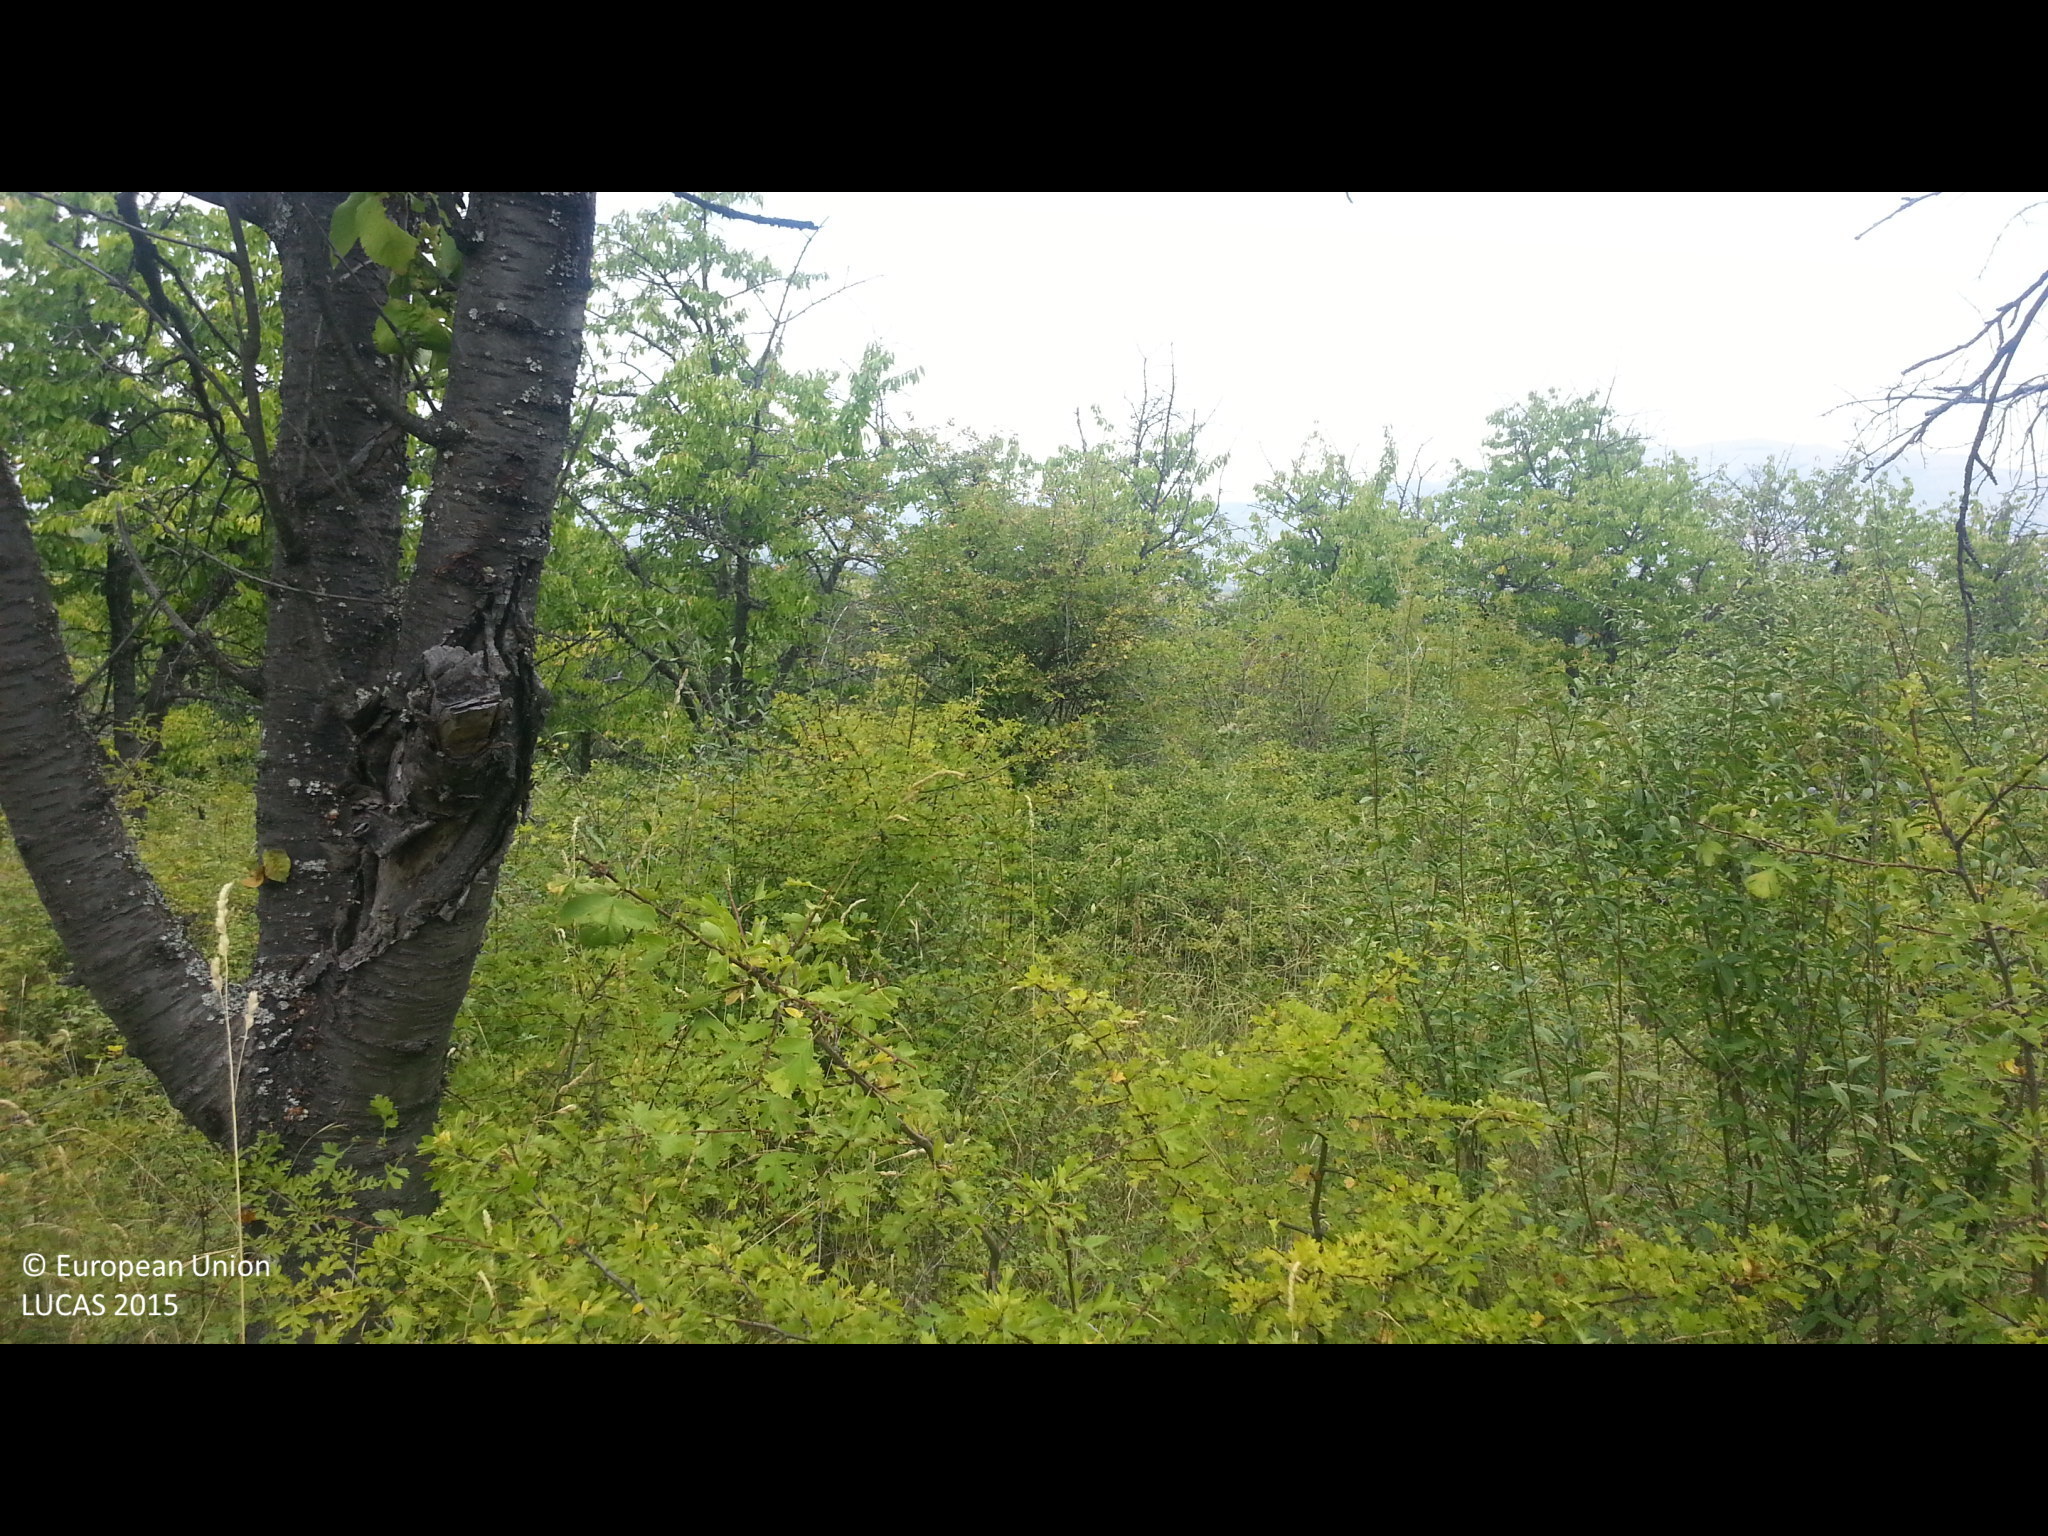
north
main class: Cropland
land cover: Cherry fruit
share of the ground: 25 - 50 %
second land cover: Shrubland without tree cover
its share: 50 - 75 %
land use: Agriculture (excluding fallow land and kitchen gardens)
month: August
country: BG
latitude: 42.2421
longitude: 22.7836
